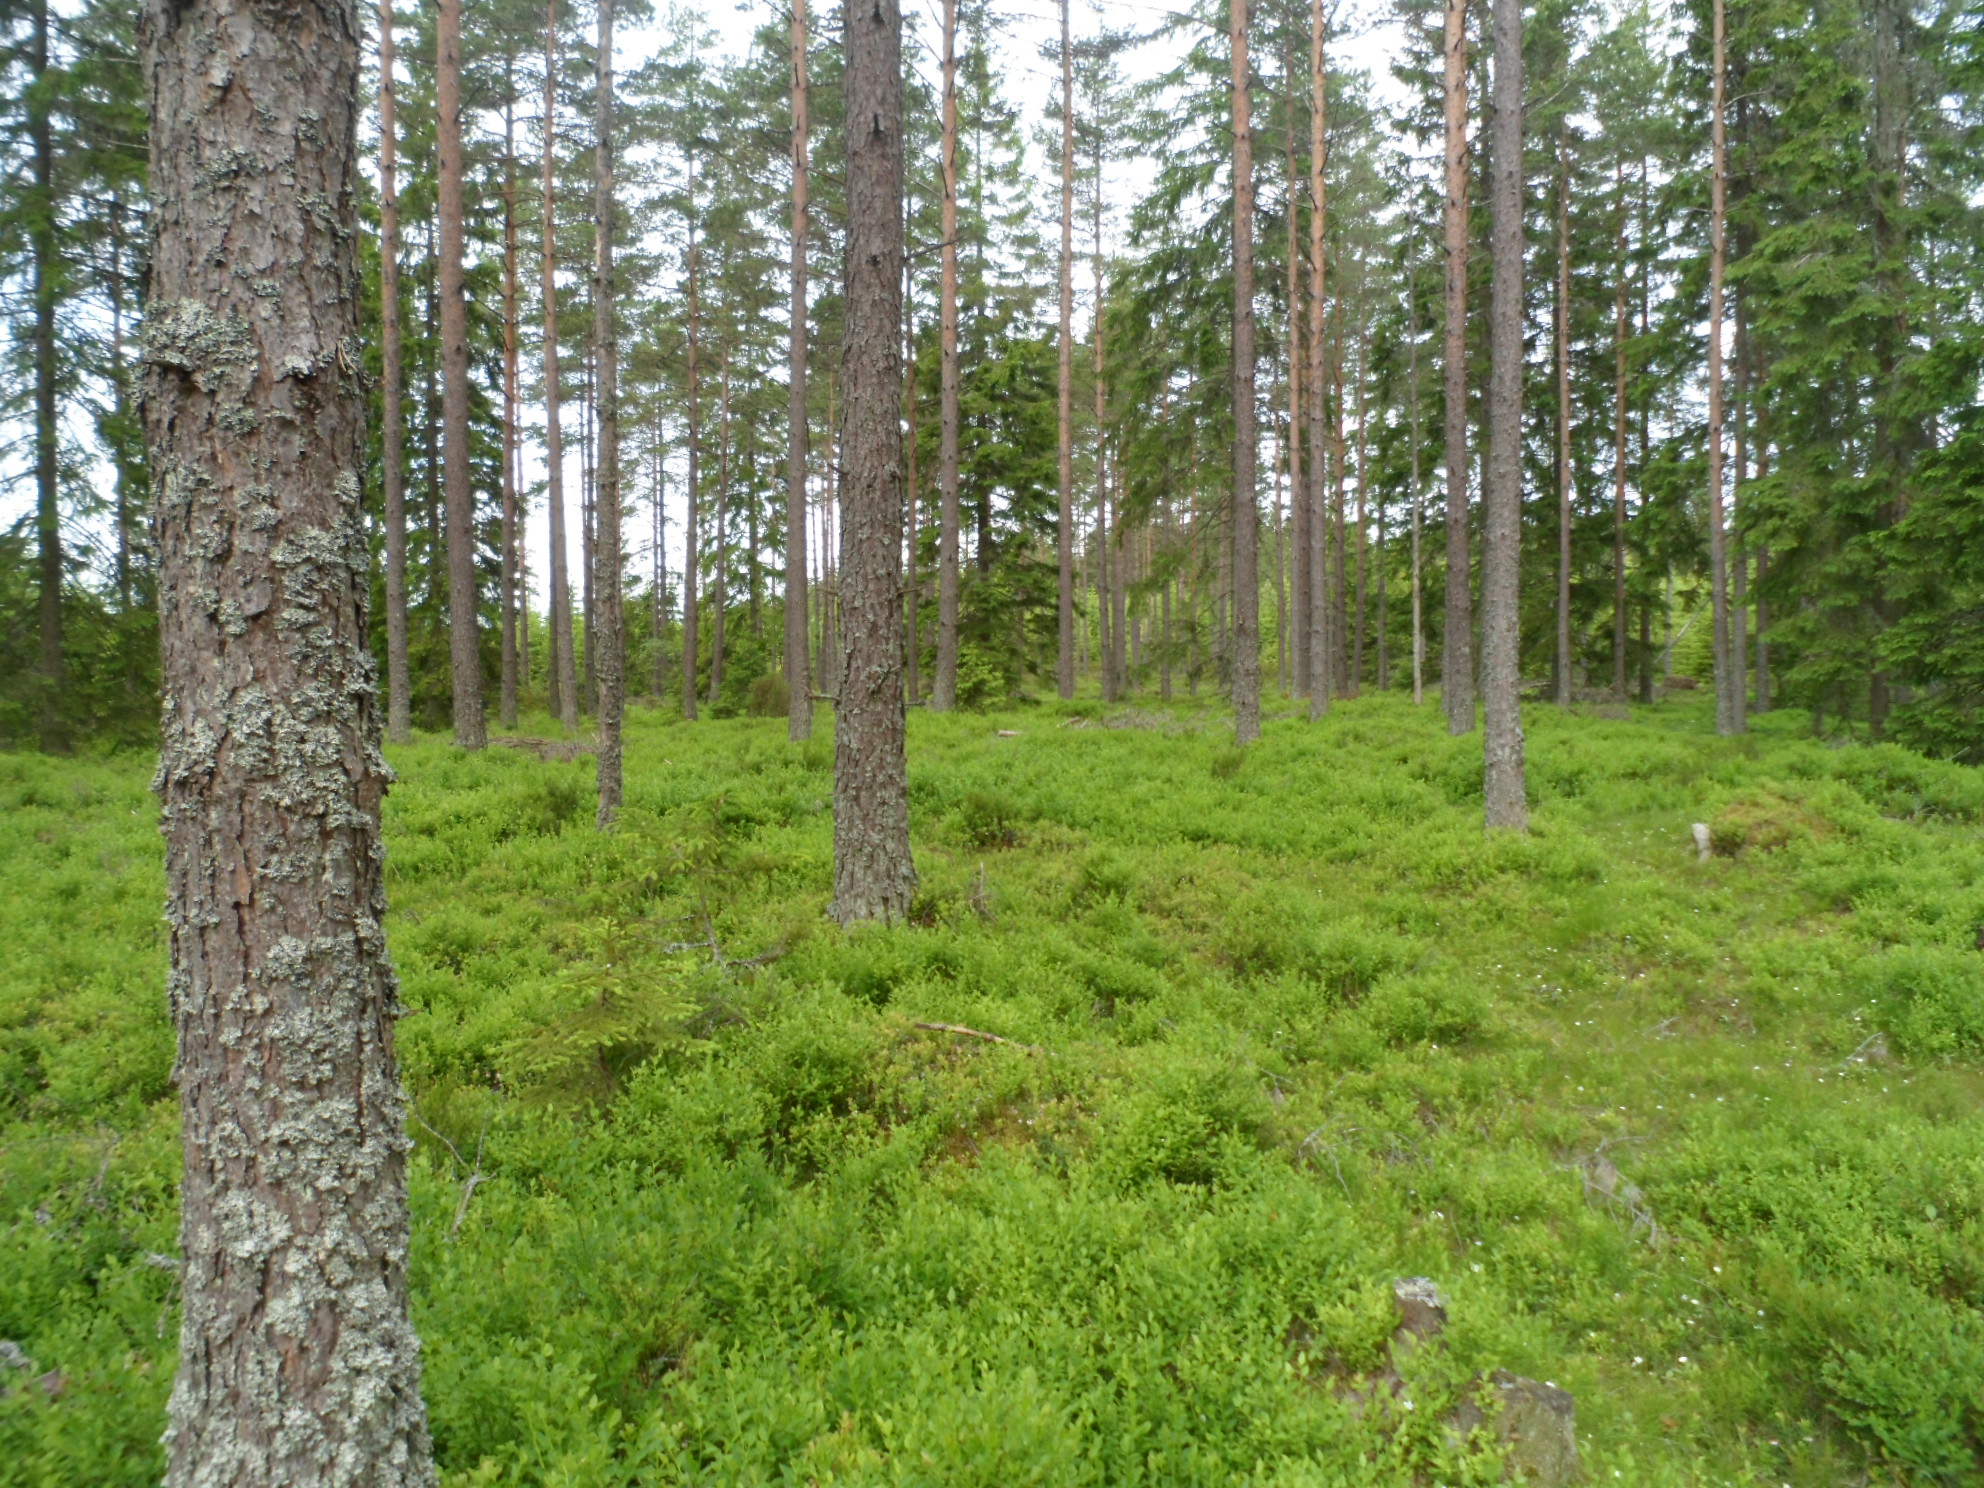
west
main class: Woodland
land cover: Pine dominated coniferous woodland
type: boreal forest
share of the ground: 50 - 75 %
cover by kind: coniferous forest trees 50 %, shrubs 30 %, lichens and mosses 15 %, herbaceous plants 5 %
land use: Forestry
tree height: > 5 m
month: June
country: SE
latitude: 57.0353
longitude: 15.2540
